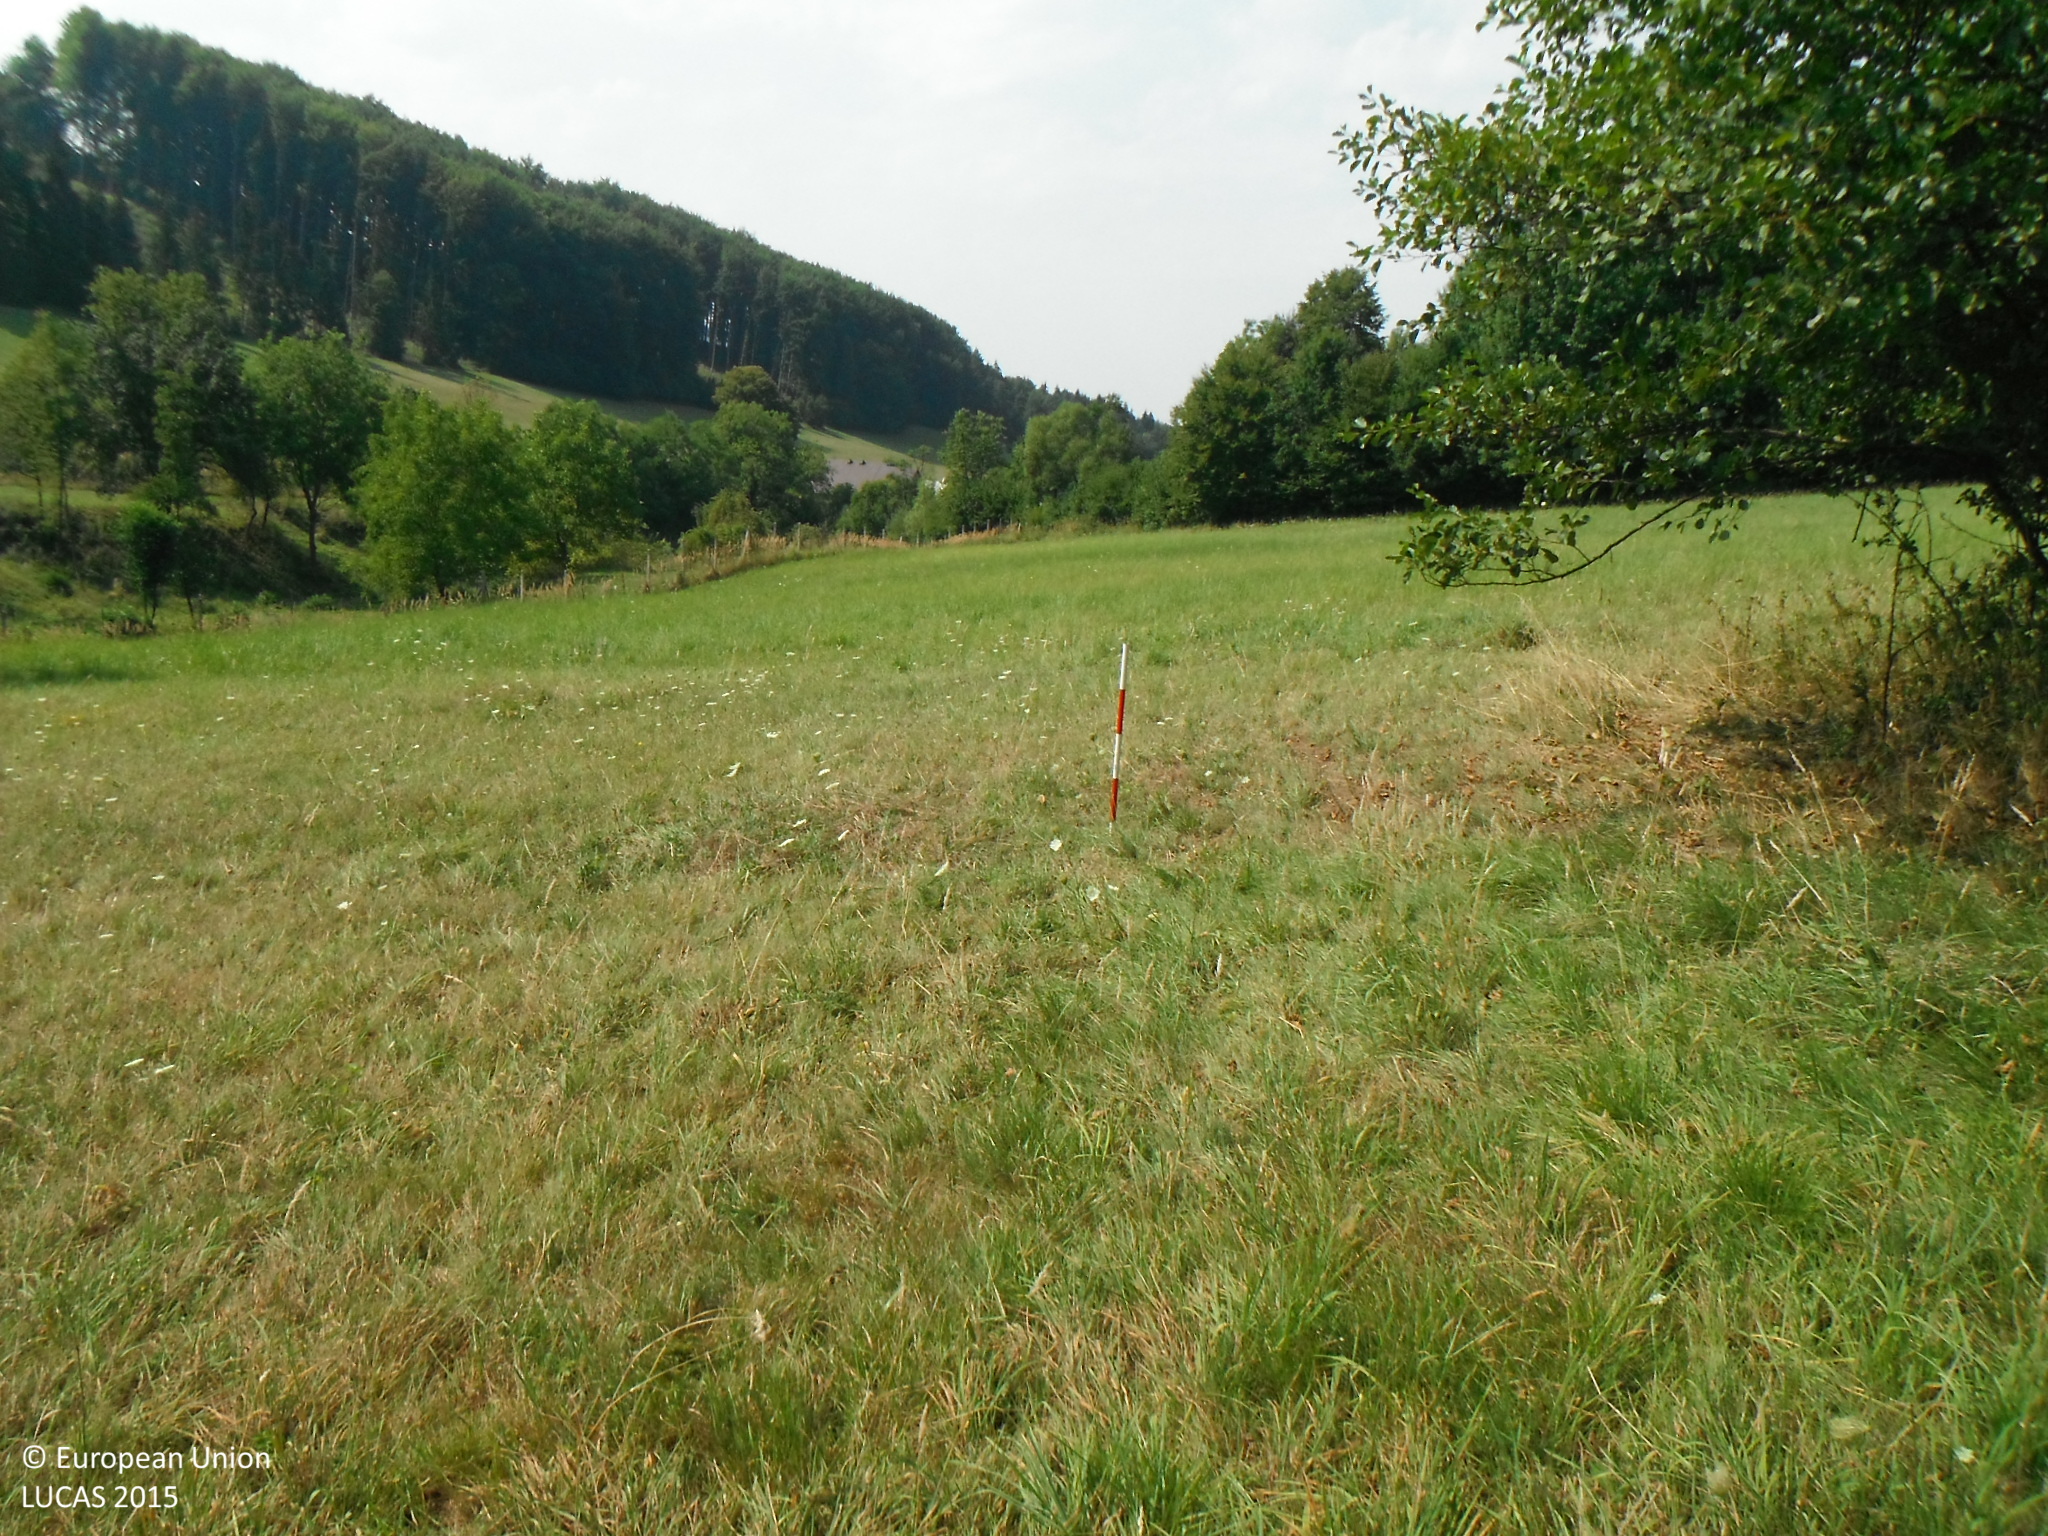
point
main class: Grassland
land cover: Grassland without tree/shrub cover
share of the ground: > 75 %
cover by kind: herbaceous plants 100 %
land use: Agriculture (excluding fallow land and kitchen gardens)
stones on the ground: < 10 %
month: August
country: SK
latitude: 49.0796
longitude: 18.3821
